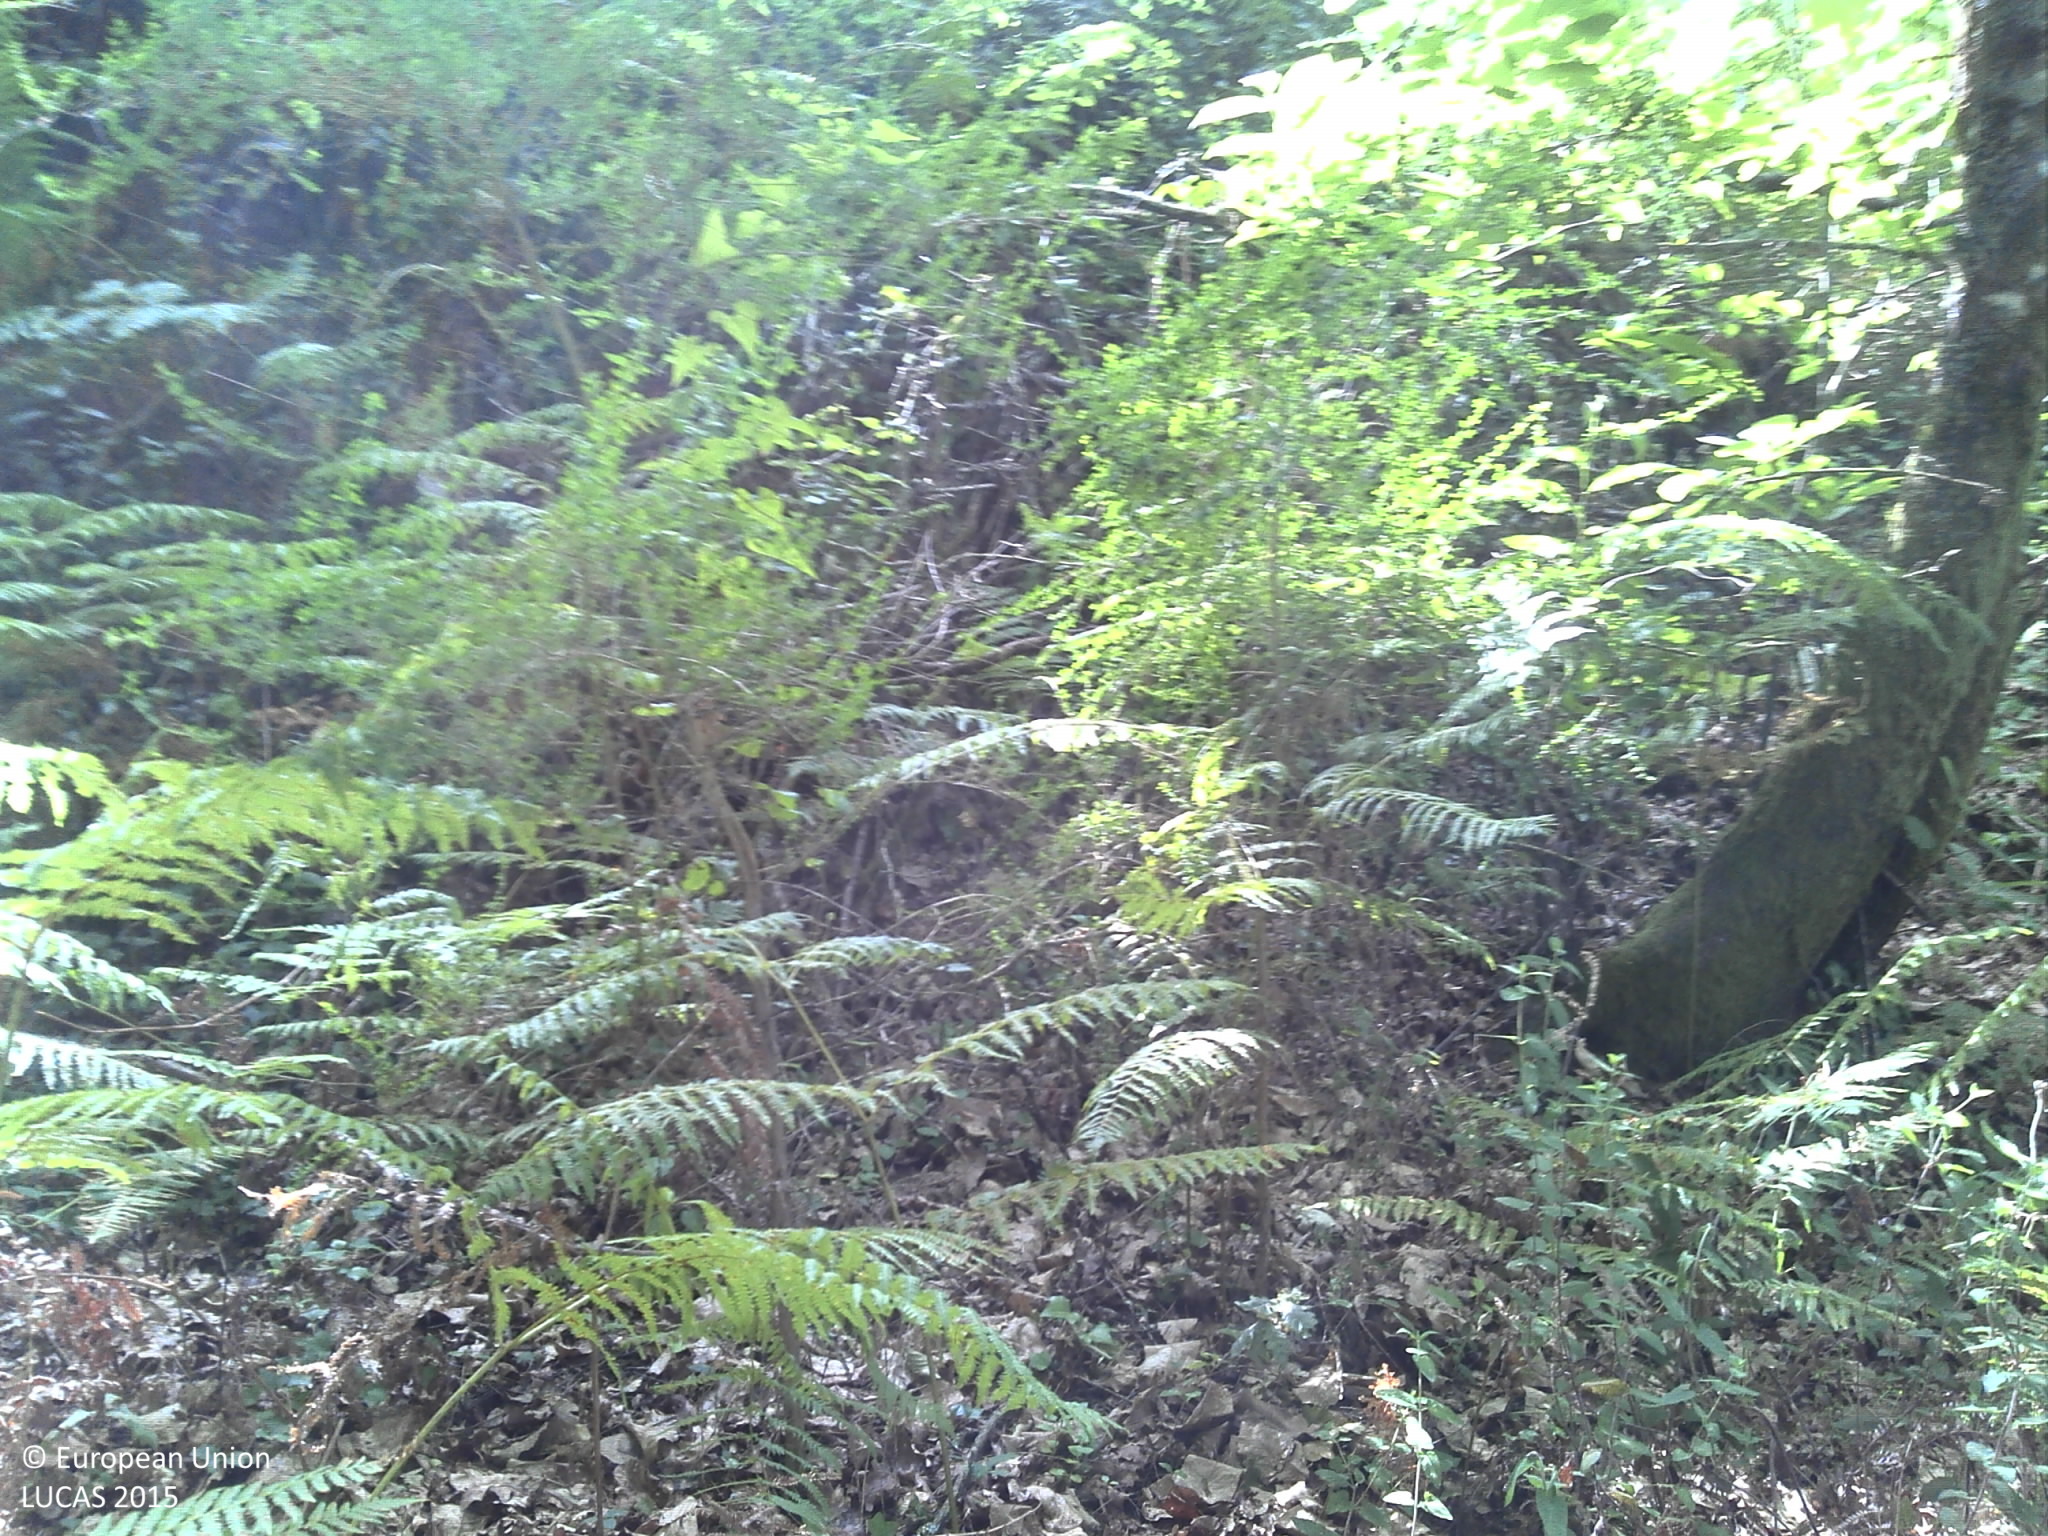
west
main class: Woodland
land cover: Pine dominated mixed woodland
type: coniferous forest of the mediterranean region
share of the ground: > 75 %
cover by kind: broadleaved forest trees 75 %, coniferous forest trees 25 %
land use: Forestry
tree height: > 5 m
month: June
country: PT
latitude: 41.7939
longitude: -8.4379
